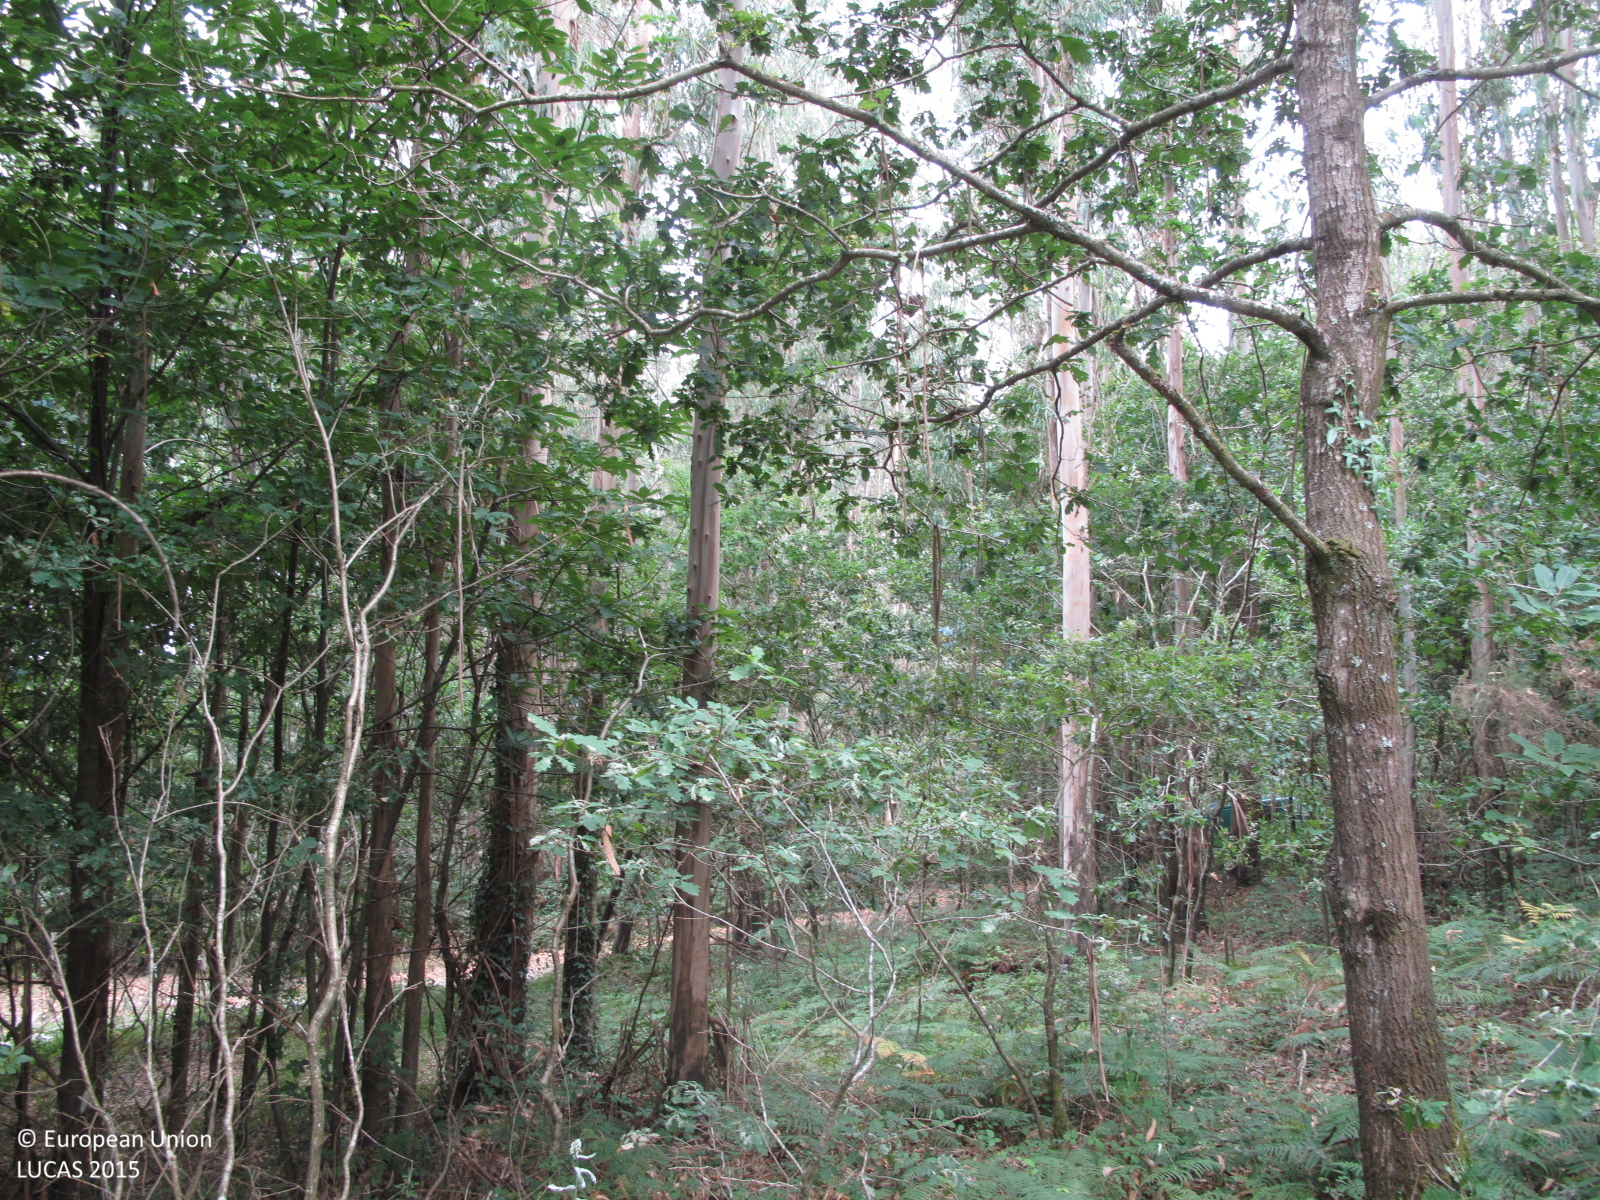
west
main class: Woodland
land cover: Broadleaved woodland
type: exotic forest
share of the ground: 50 - 75 %
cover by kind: broadleaved forest trees 60 %, shrubs 20 %, herbaceous plants 20 %
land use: Forestry
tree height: > 5 m
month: July
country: ES
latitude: 42.8632
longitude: -8.4488
